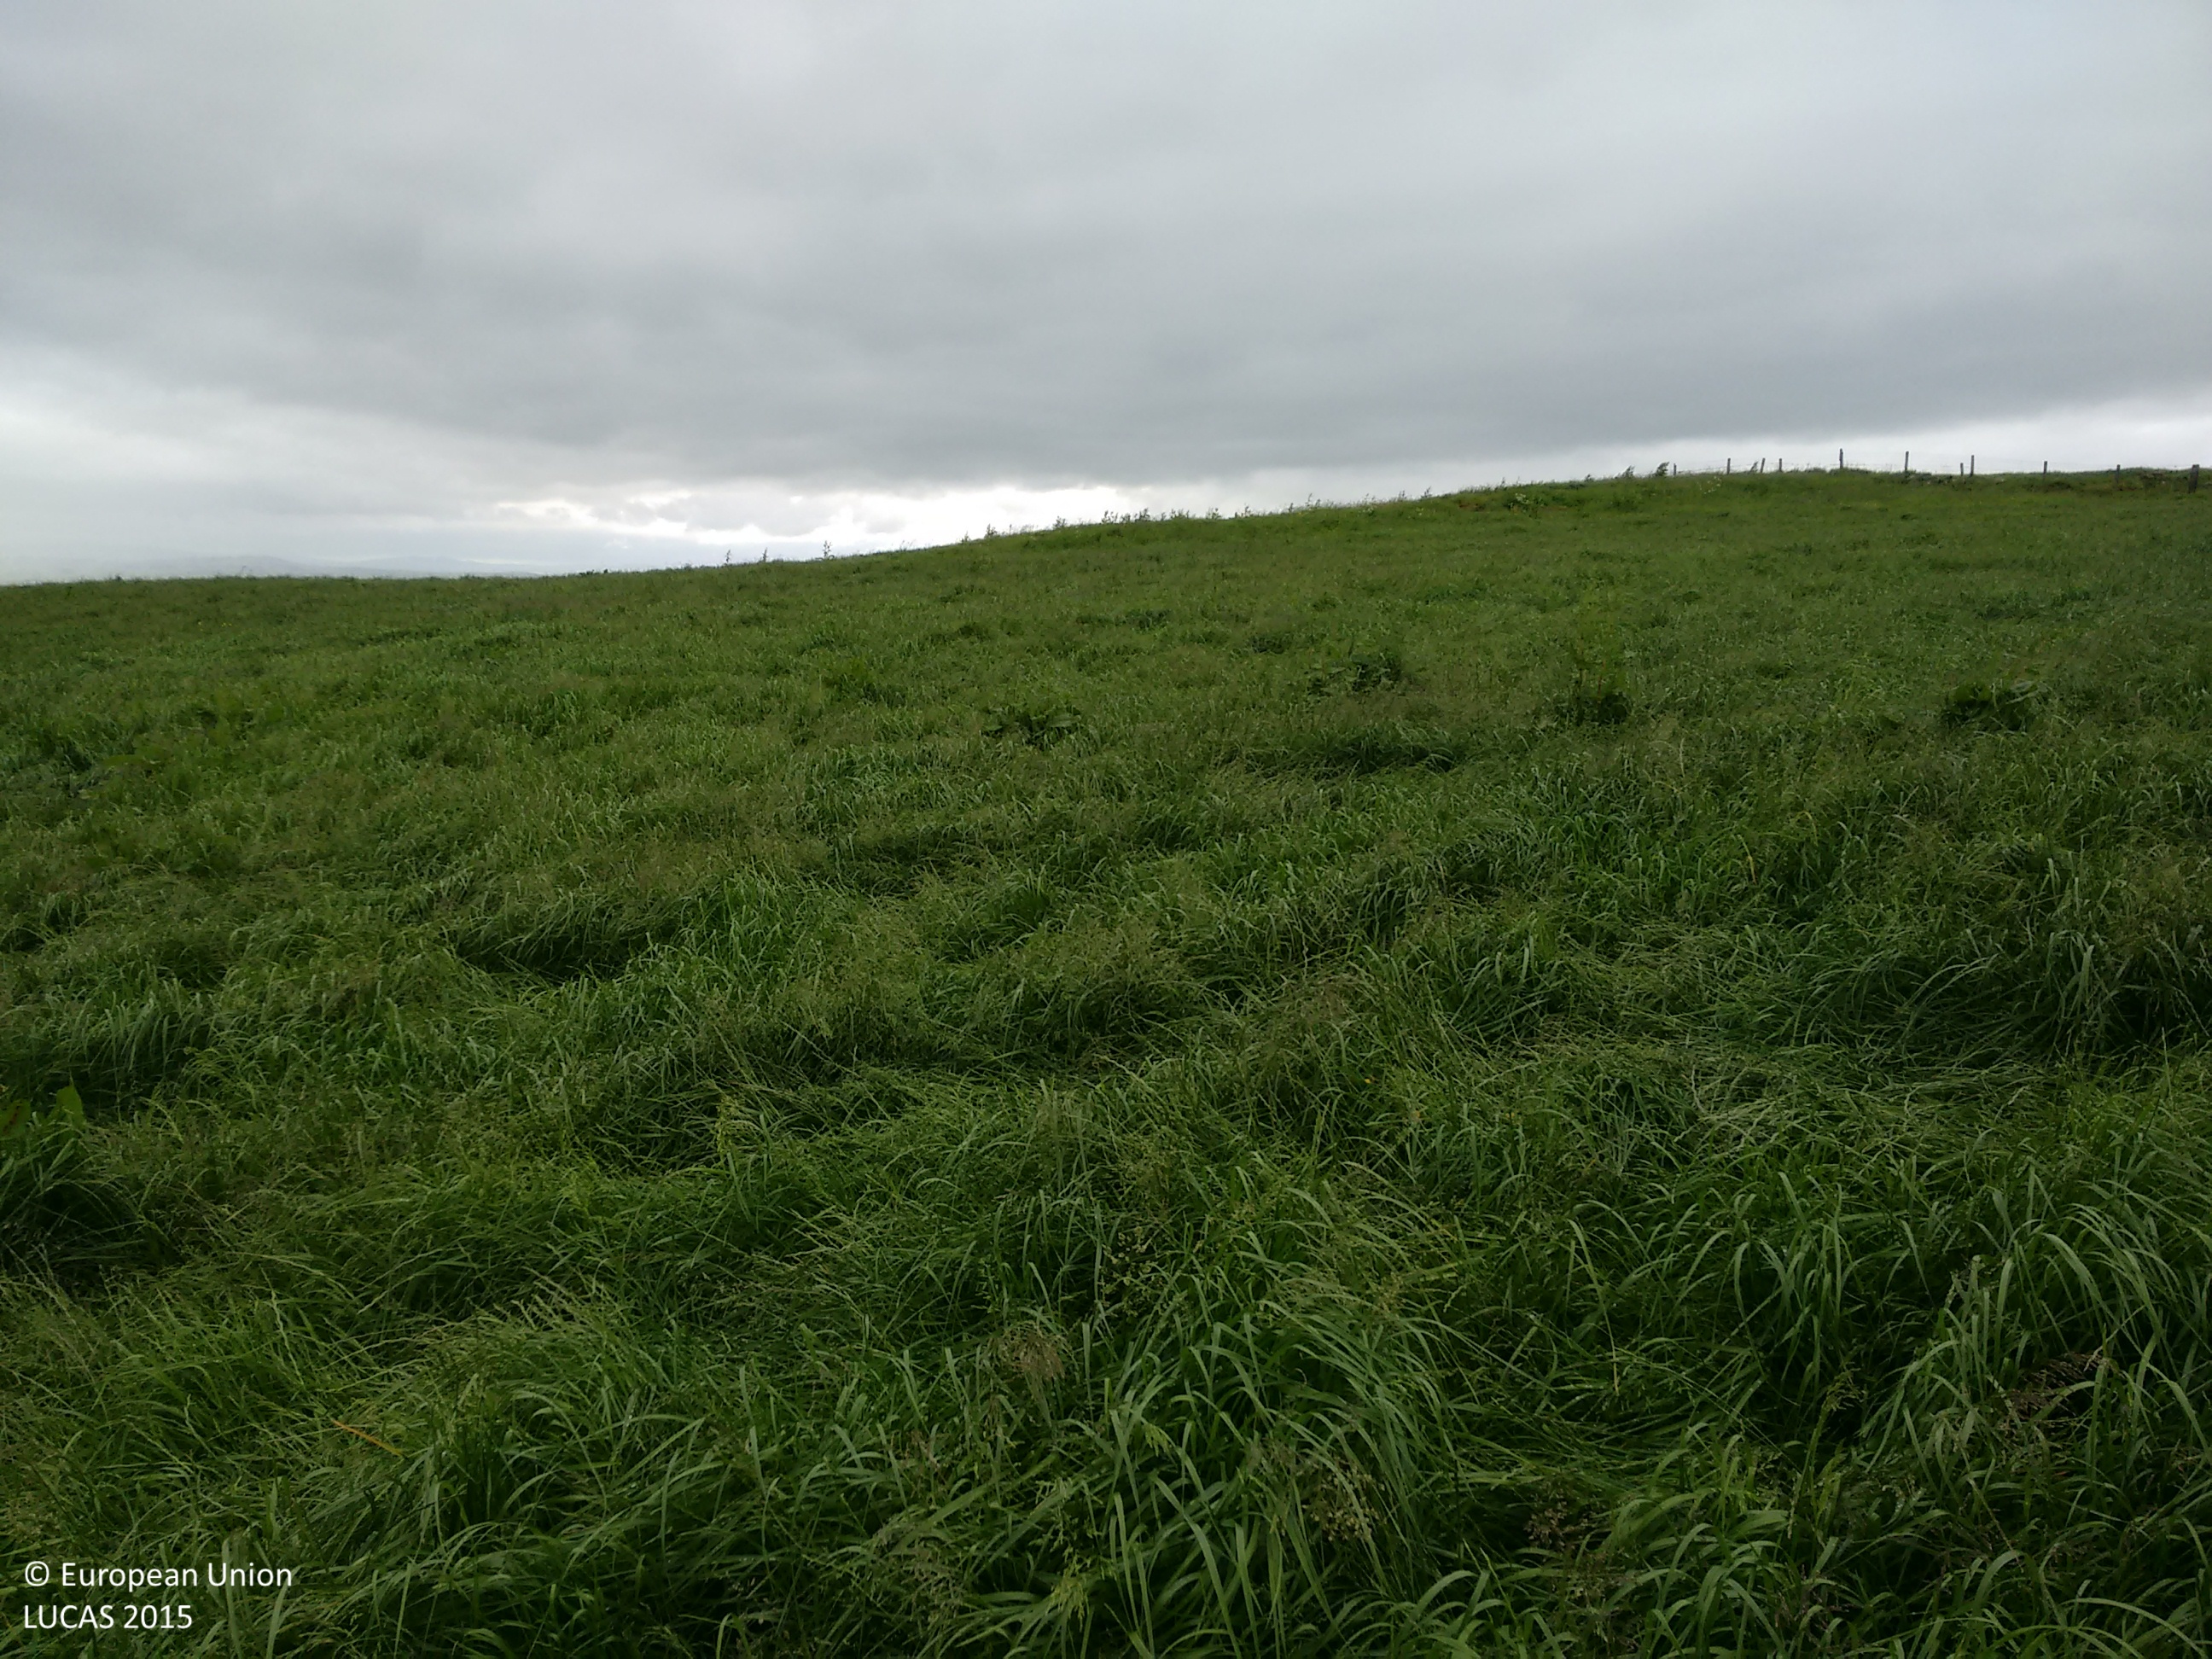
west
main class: Grassland
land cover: Grassland without tree/shrub cover
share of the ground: > 75 %
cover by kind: herbaceous plants 100 %
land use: Agriculture (excluding fallow land and kitchen gardens)
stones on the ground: < 10 %
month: June
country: GB
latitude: 55.7160
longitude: -3.7570
